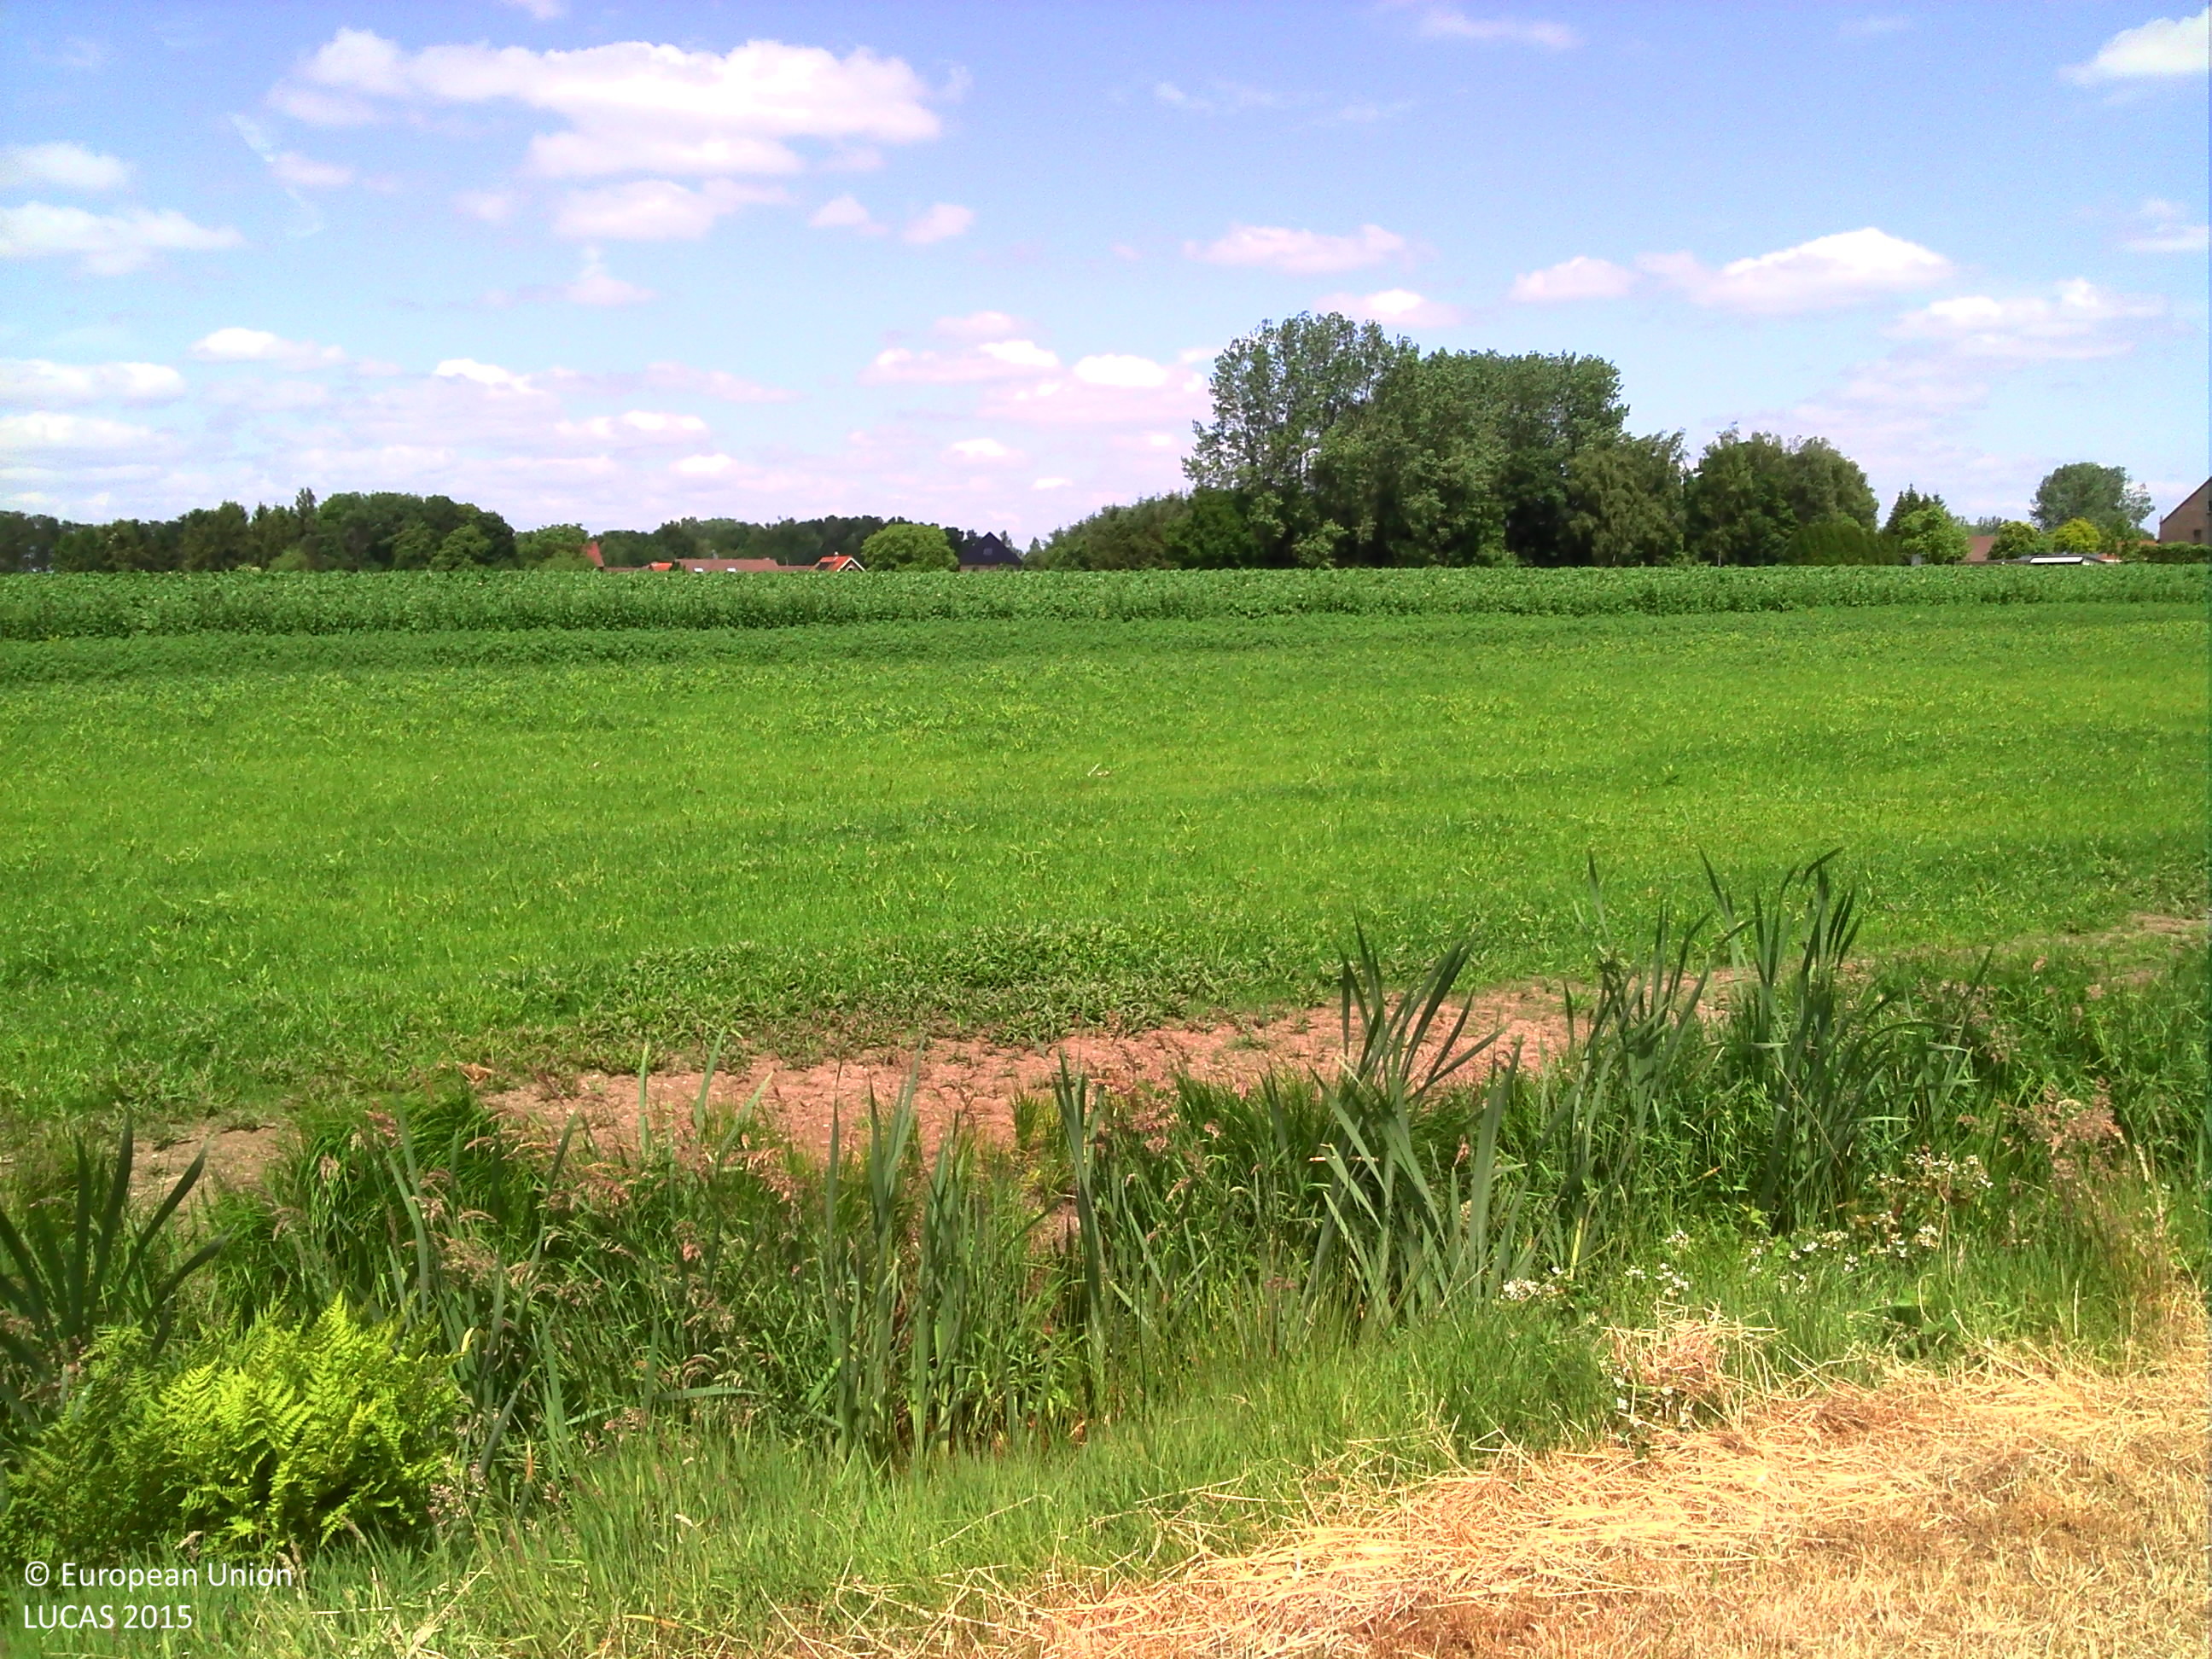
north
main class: Grassland
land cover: Grassland without tree/shrub cover
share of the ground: > 75 %
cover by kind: herbaceous plants 100 %
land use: Agriculture (excluding fallow land and kitchen gardens)
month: June
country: BE
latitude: 51.1484
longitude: 5.7242
